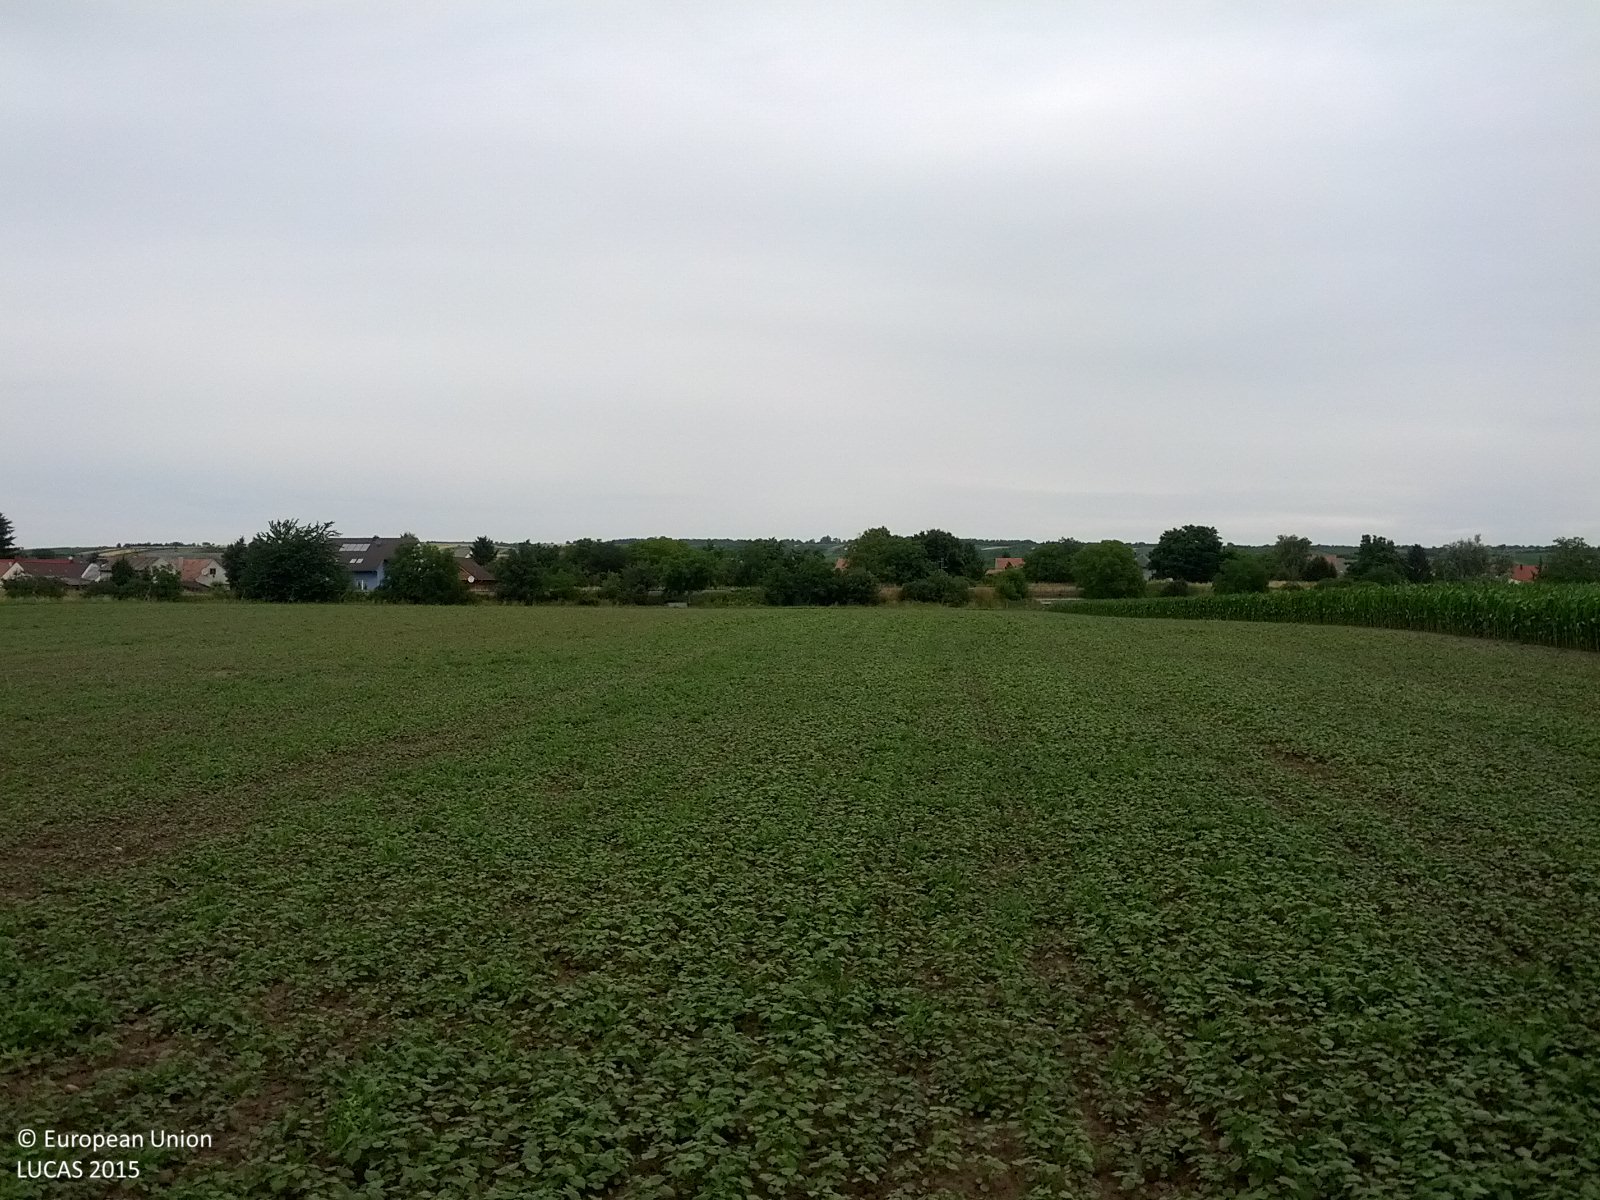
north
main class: Cropland
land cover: Other cereals
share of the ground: > 75 %
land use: Agriculture (excluding fallow land and kitchen gardens)
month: June
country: AT
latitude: 48.3520
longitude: 16.5779
